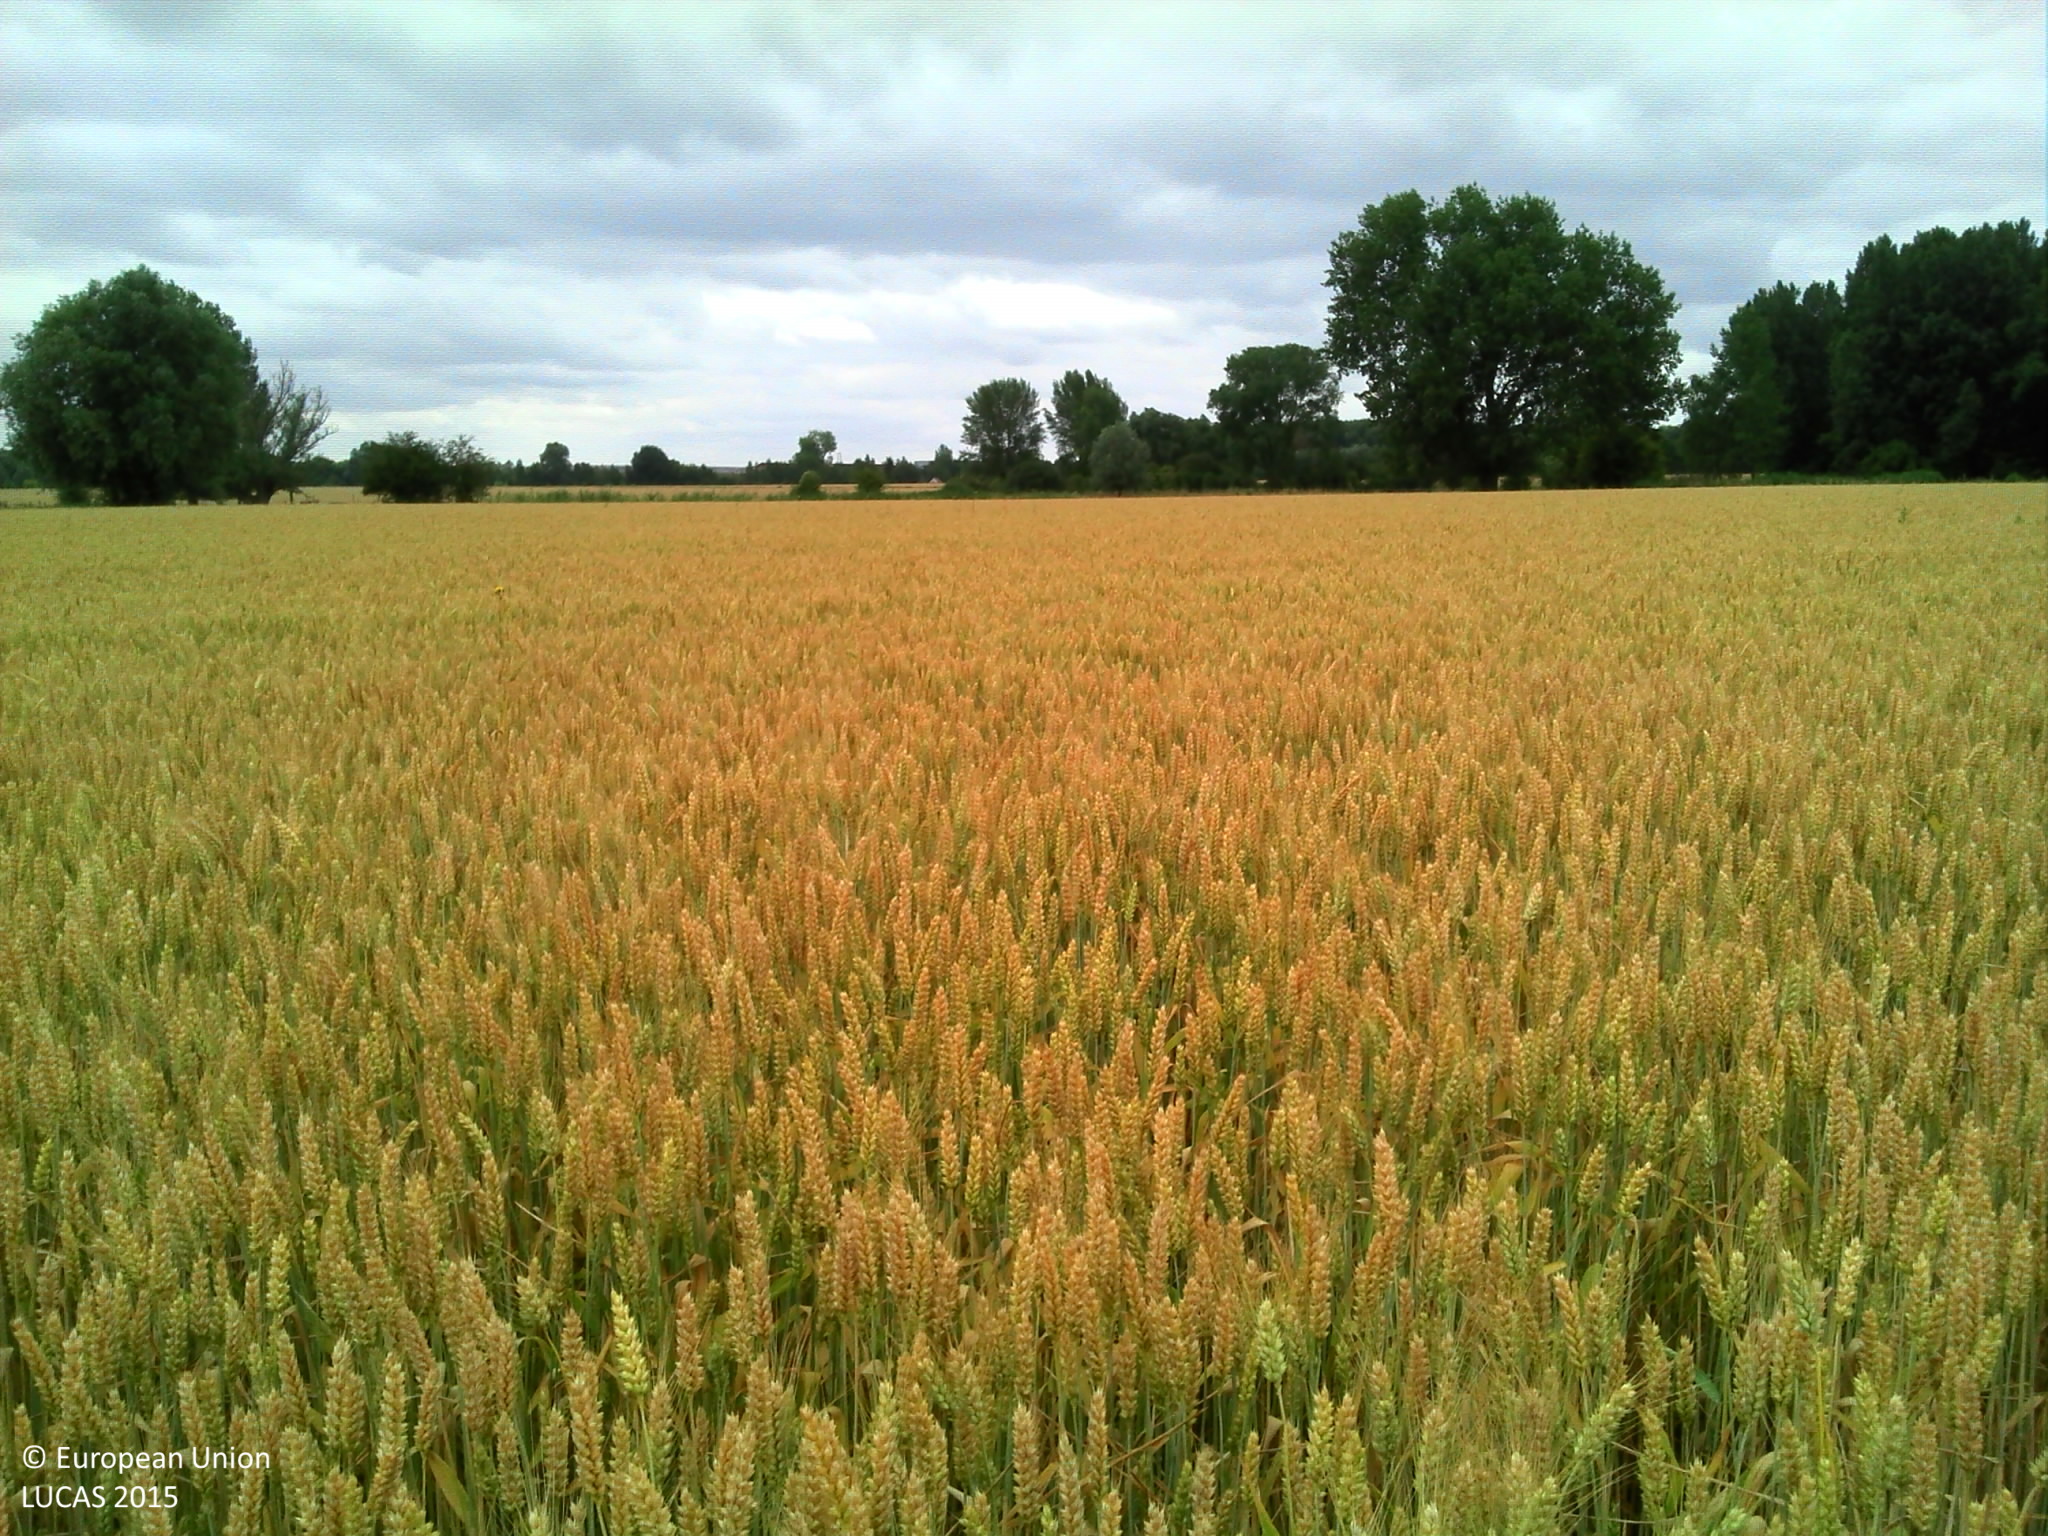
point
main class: Cropland
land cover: Common wheat
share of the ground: > 75 %
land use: Agriculture (excluding fallow land and kitchen gardens)
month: July
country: FR
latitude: 50.4251
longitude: 3.0791
